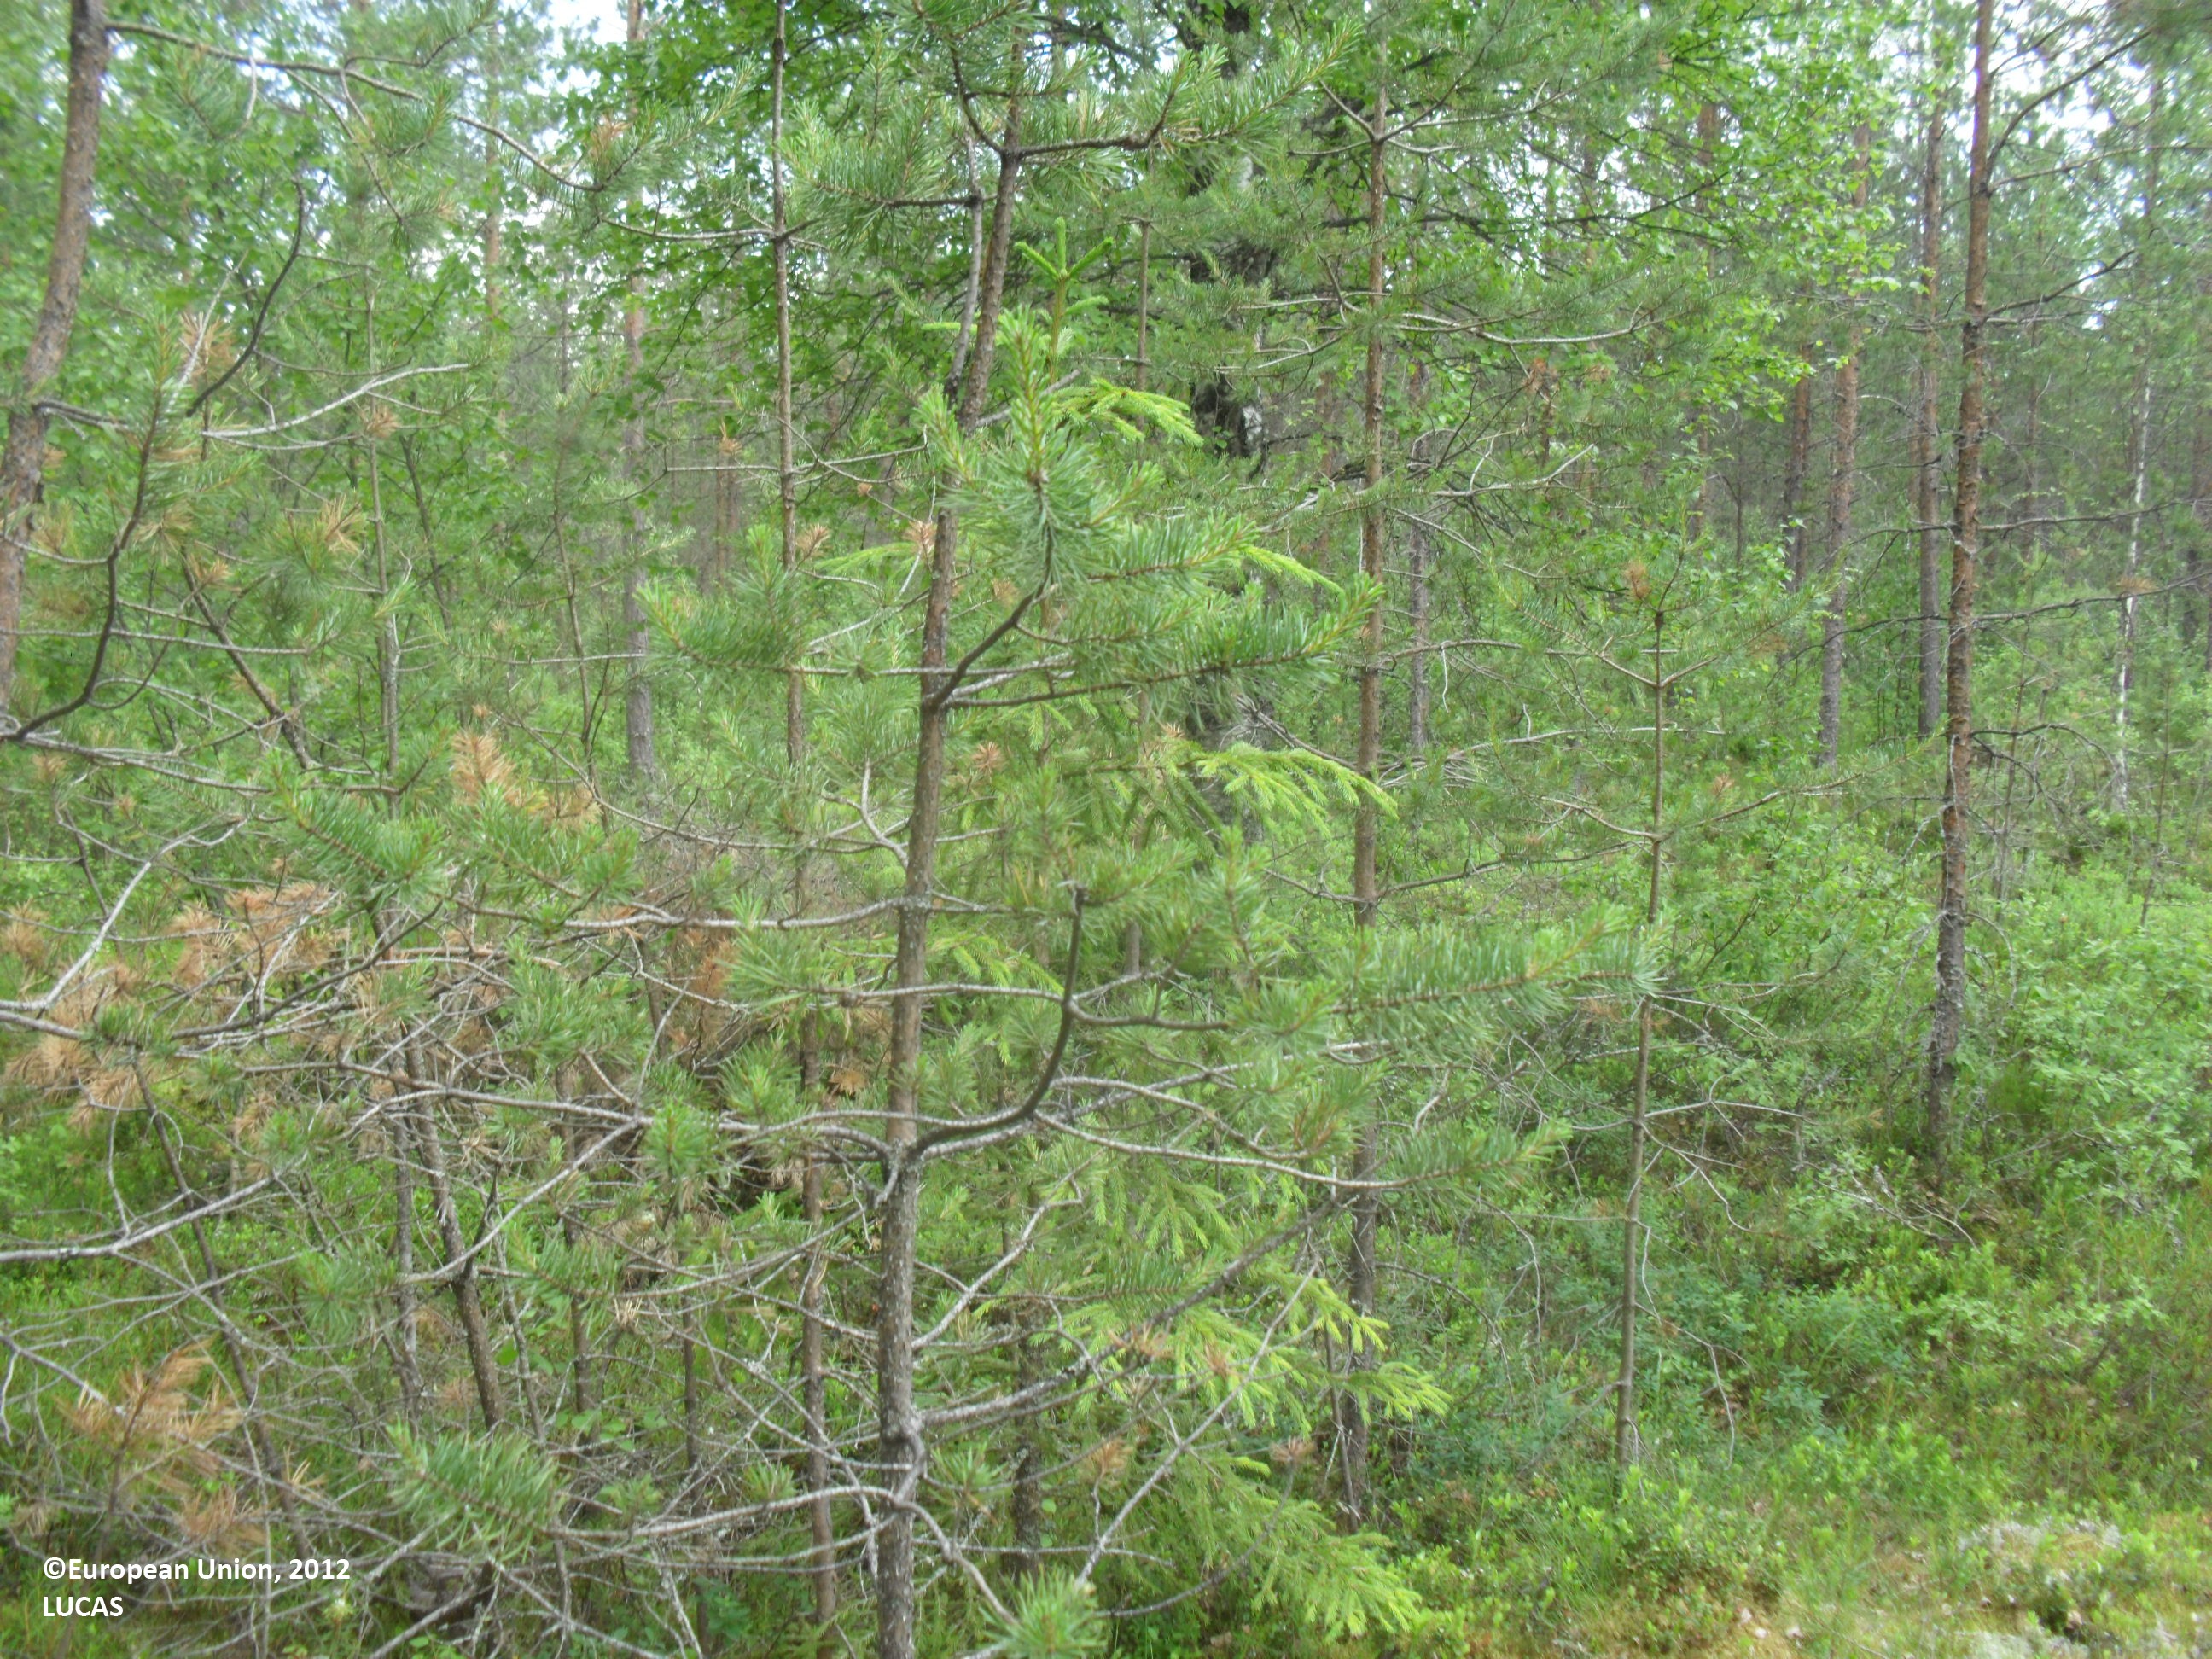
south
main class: Woodland
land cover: Other mixed woodland
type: boreal forest
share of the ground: 25 - 50 %
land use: Forestry
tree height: > 5 m
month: July
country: FI
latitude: 63.4916
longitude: 23.8645
